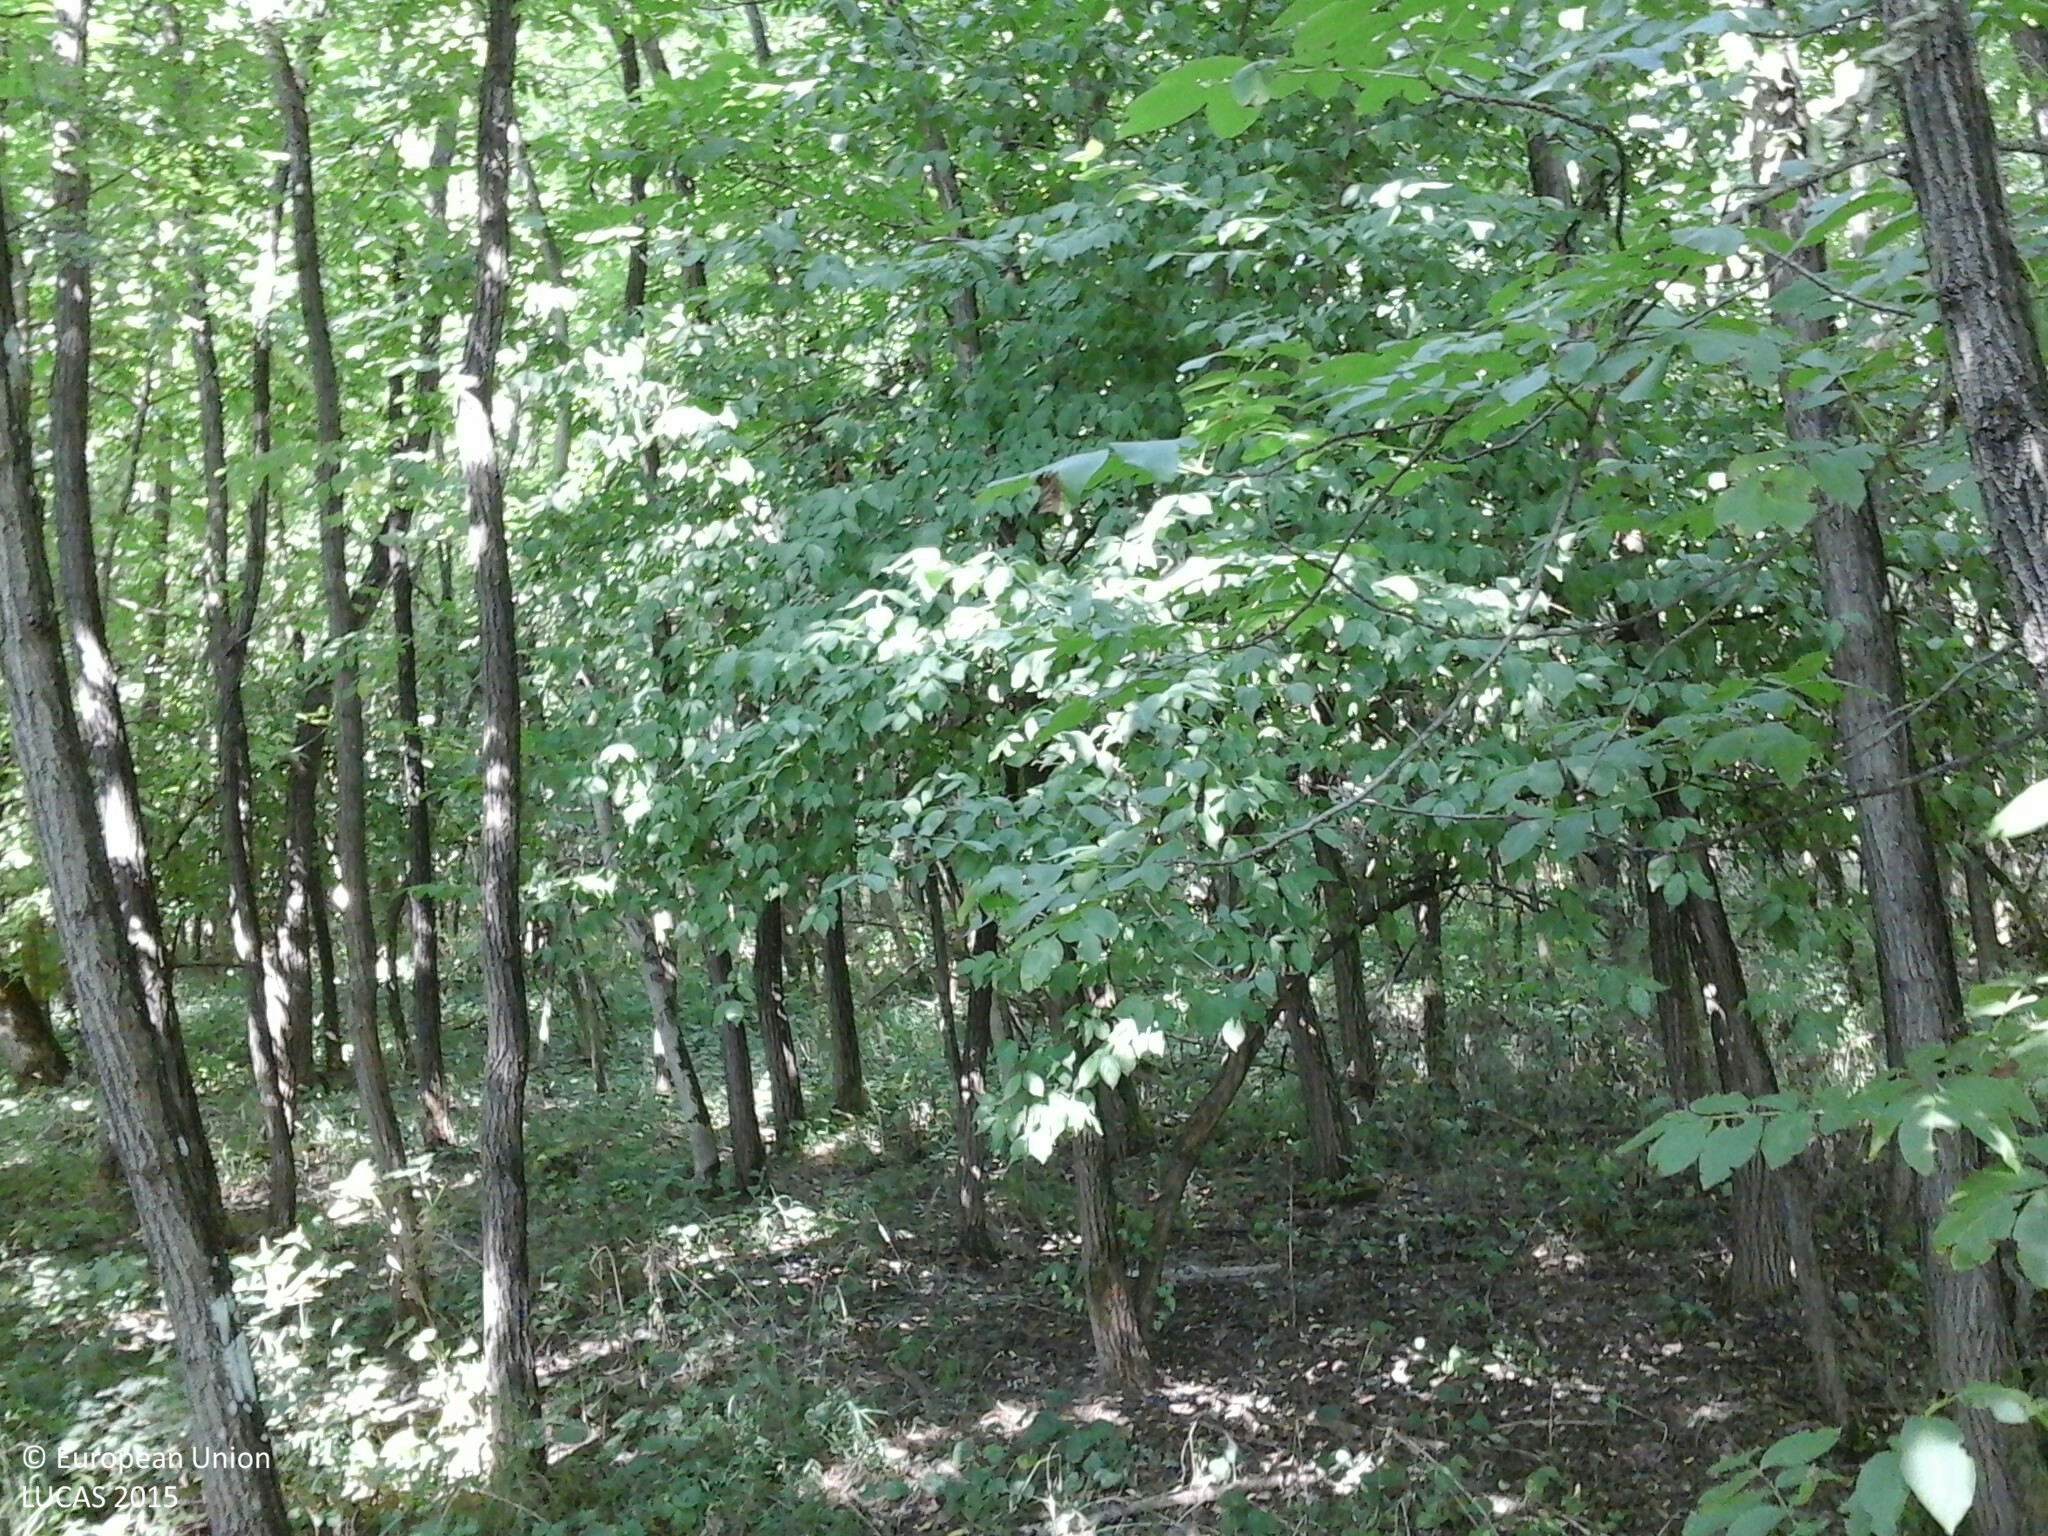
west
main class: Woodland
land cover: Broadleaved woodland
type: mesophytic deciduous forest
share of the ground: > 75 %
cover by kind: broadleaved forest trees 85 %, shrubs 10 %, herbaceous plants 5 %
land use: Forestry
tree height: > 5 m
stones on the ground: < 10 %
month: August
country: HU
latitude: 46.7128
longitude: 18.1061
